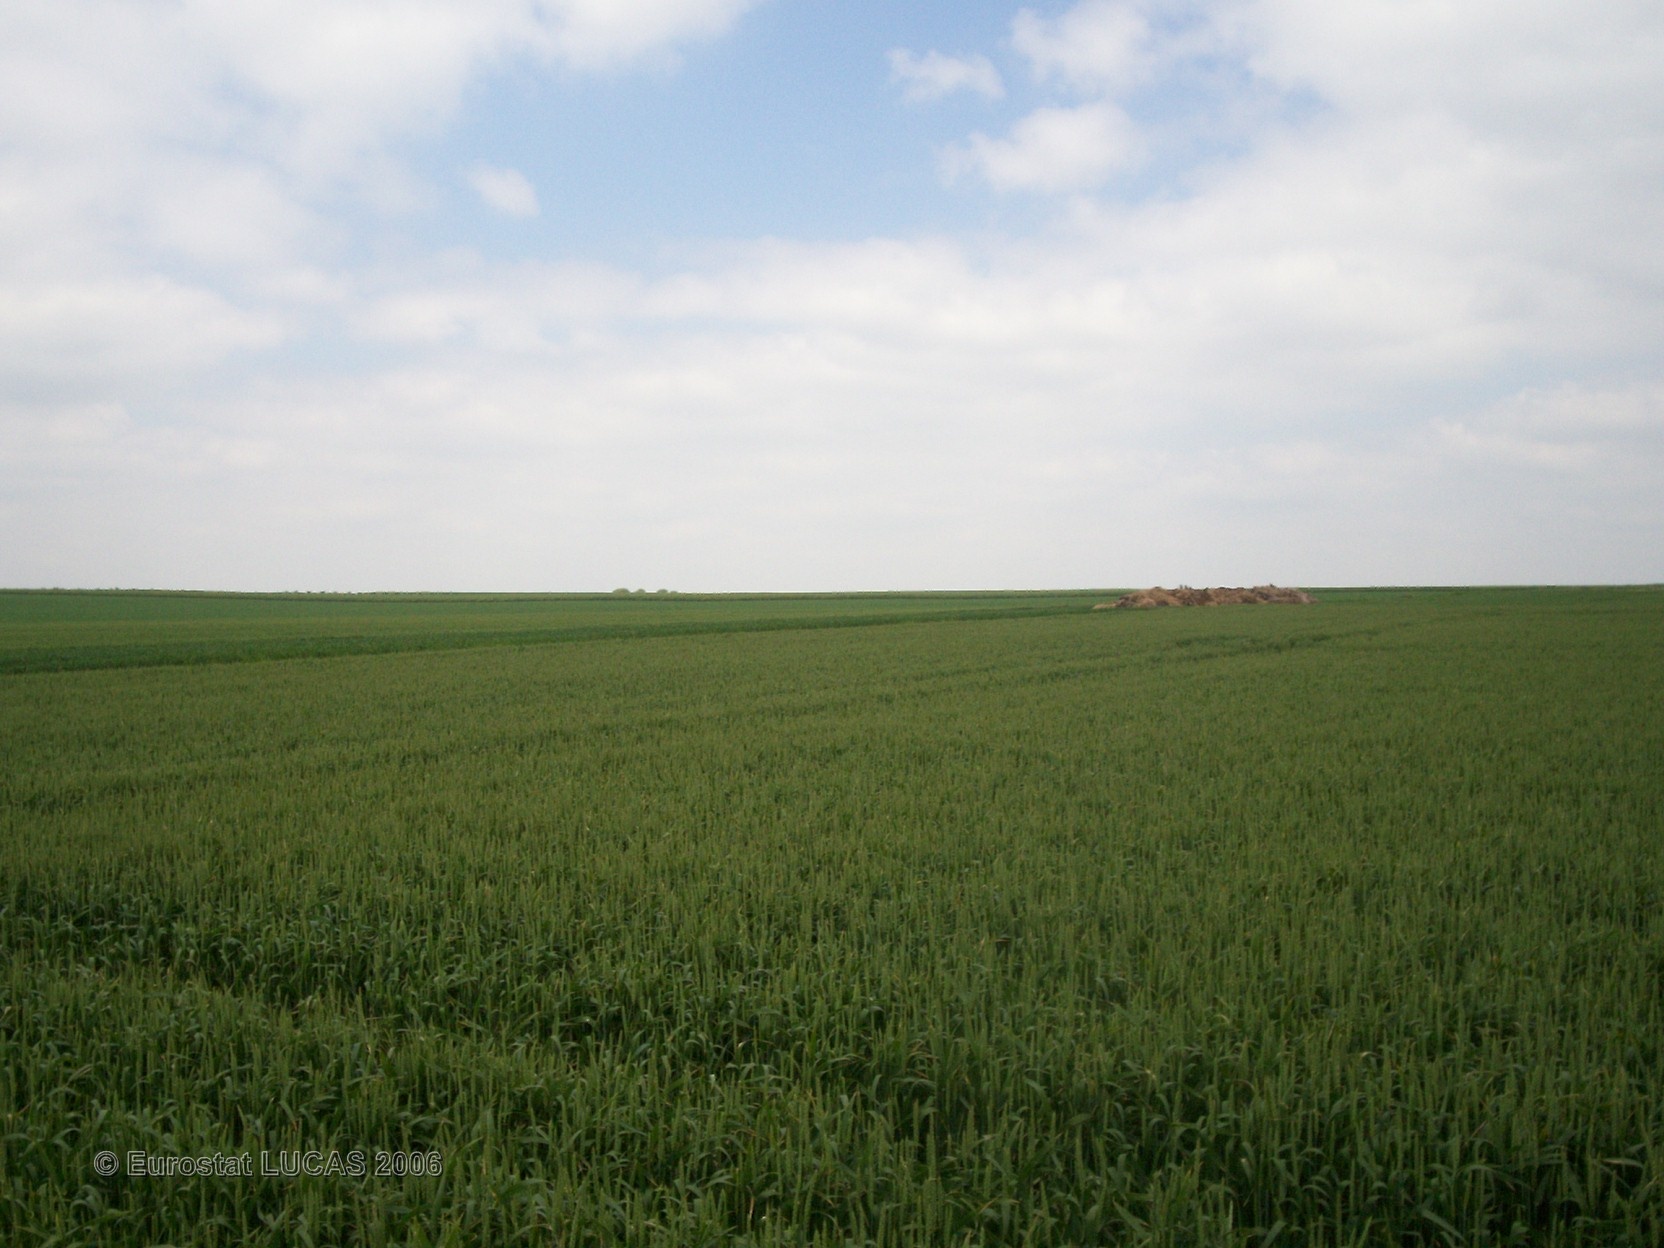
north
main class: Cropland
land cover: Common wheat
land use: Agriculture (excluding fallow land and kitchen gardens)
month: June
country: FR
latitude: 49.9268
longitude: 2.6194
